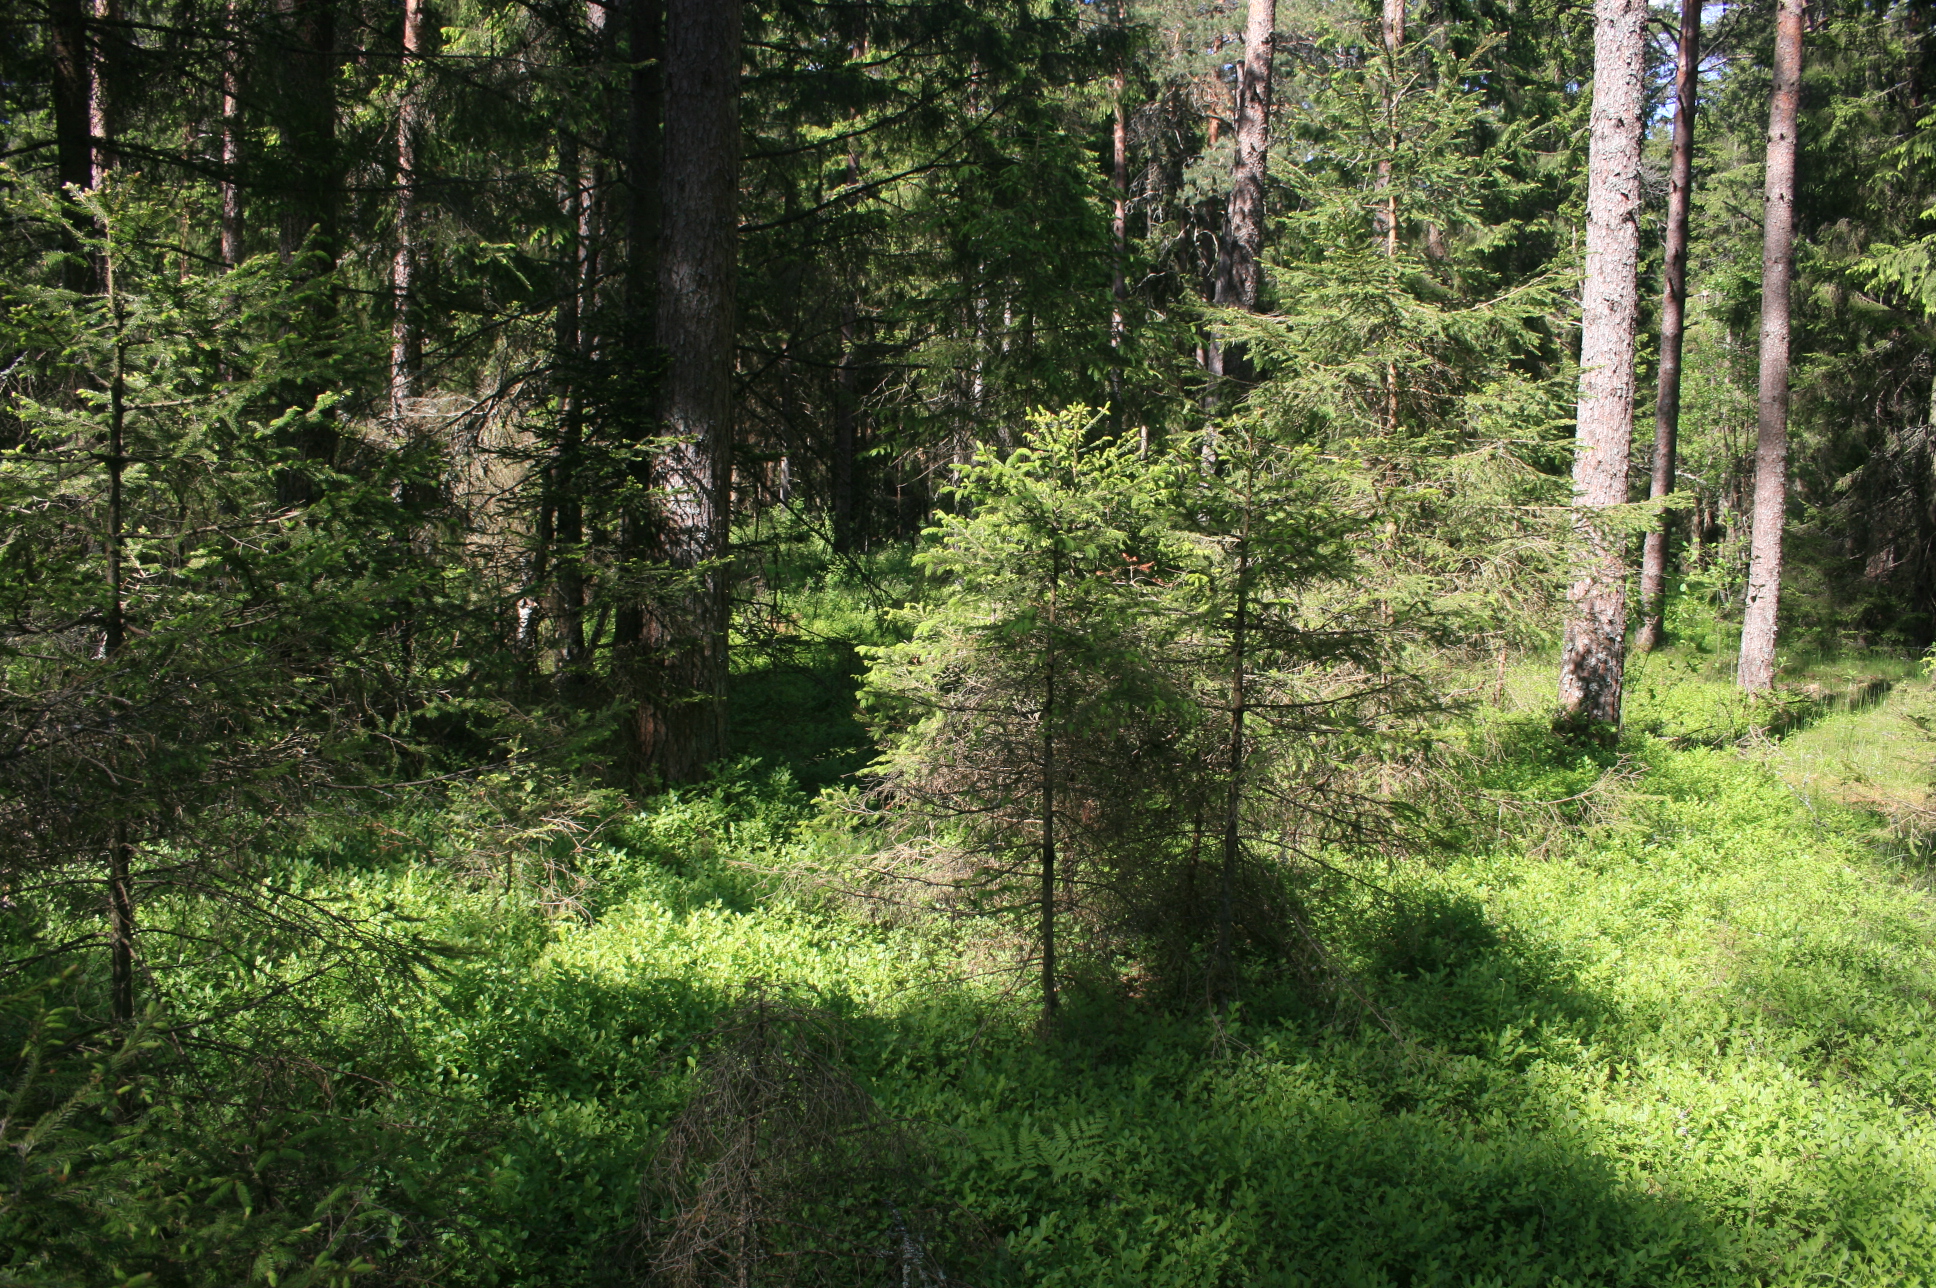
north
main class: Woodland
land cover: Spruce dominated coniferous woodland
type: hemiboreal forest and nemoral coniferous forest and mixed broadleaved-coniferous forest
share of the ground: > 75 %
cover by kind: coniferous forest trees 85 %, broadleaved forest trees 10 %, herbaceous plants 5 %
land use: Forestry
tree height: > 5 m
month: June
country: LT
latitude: 55.7976
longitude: 22.2588
